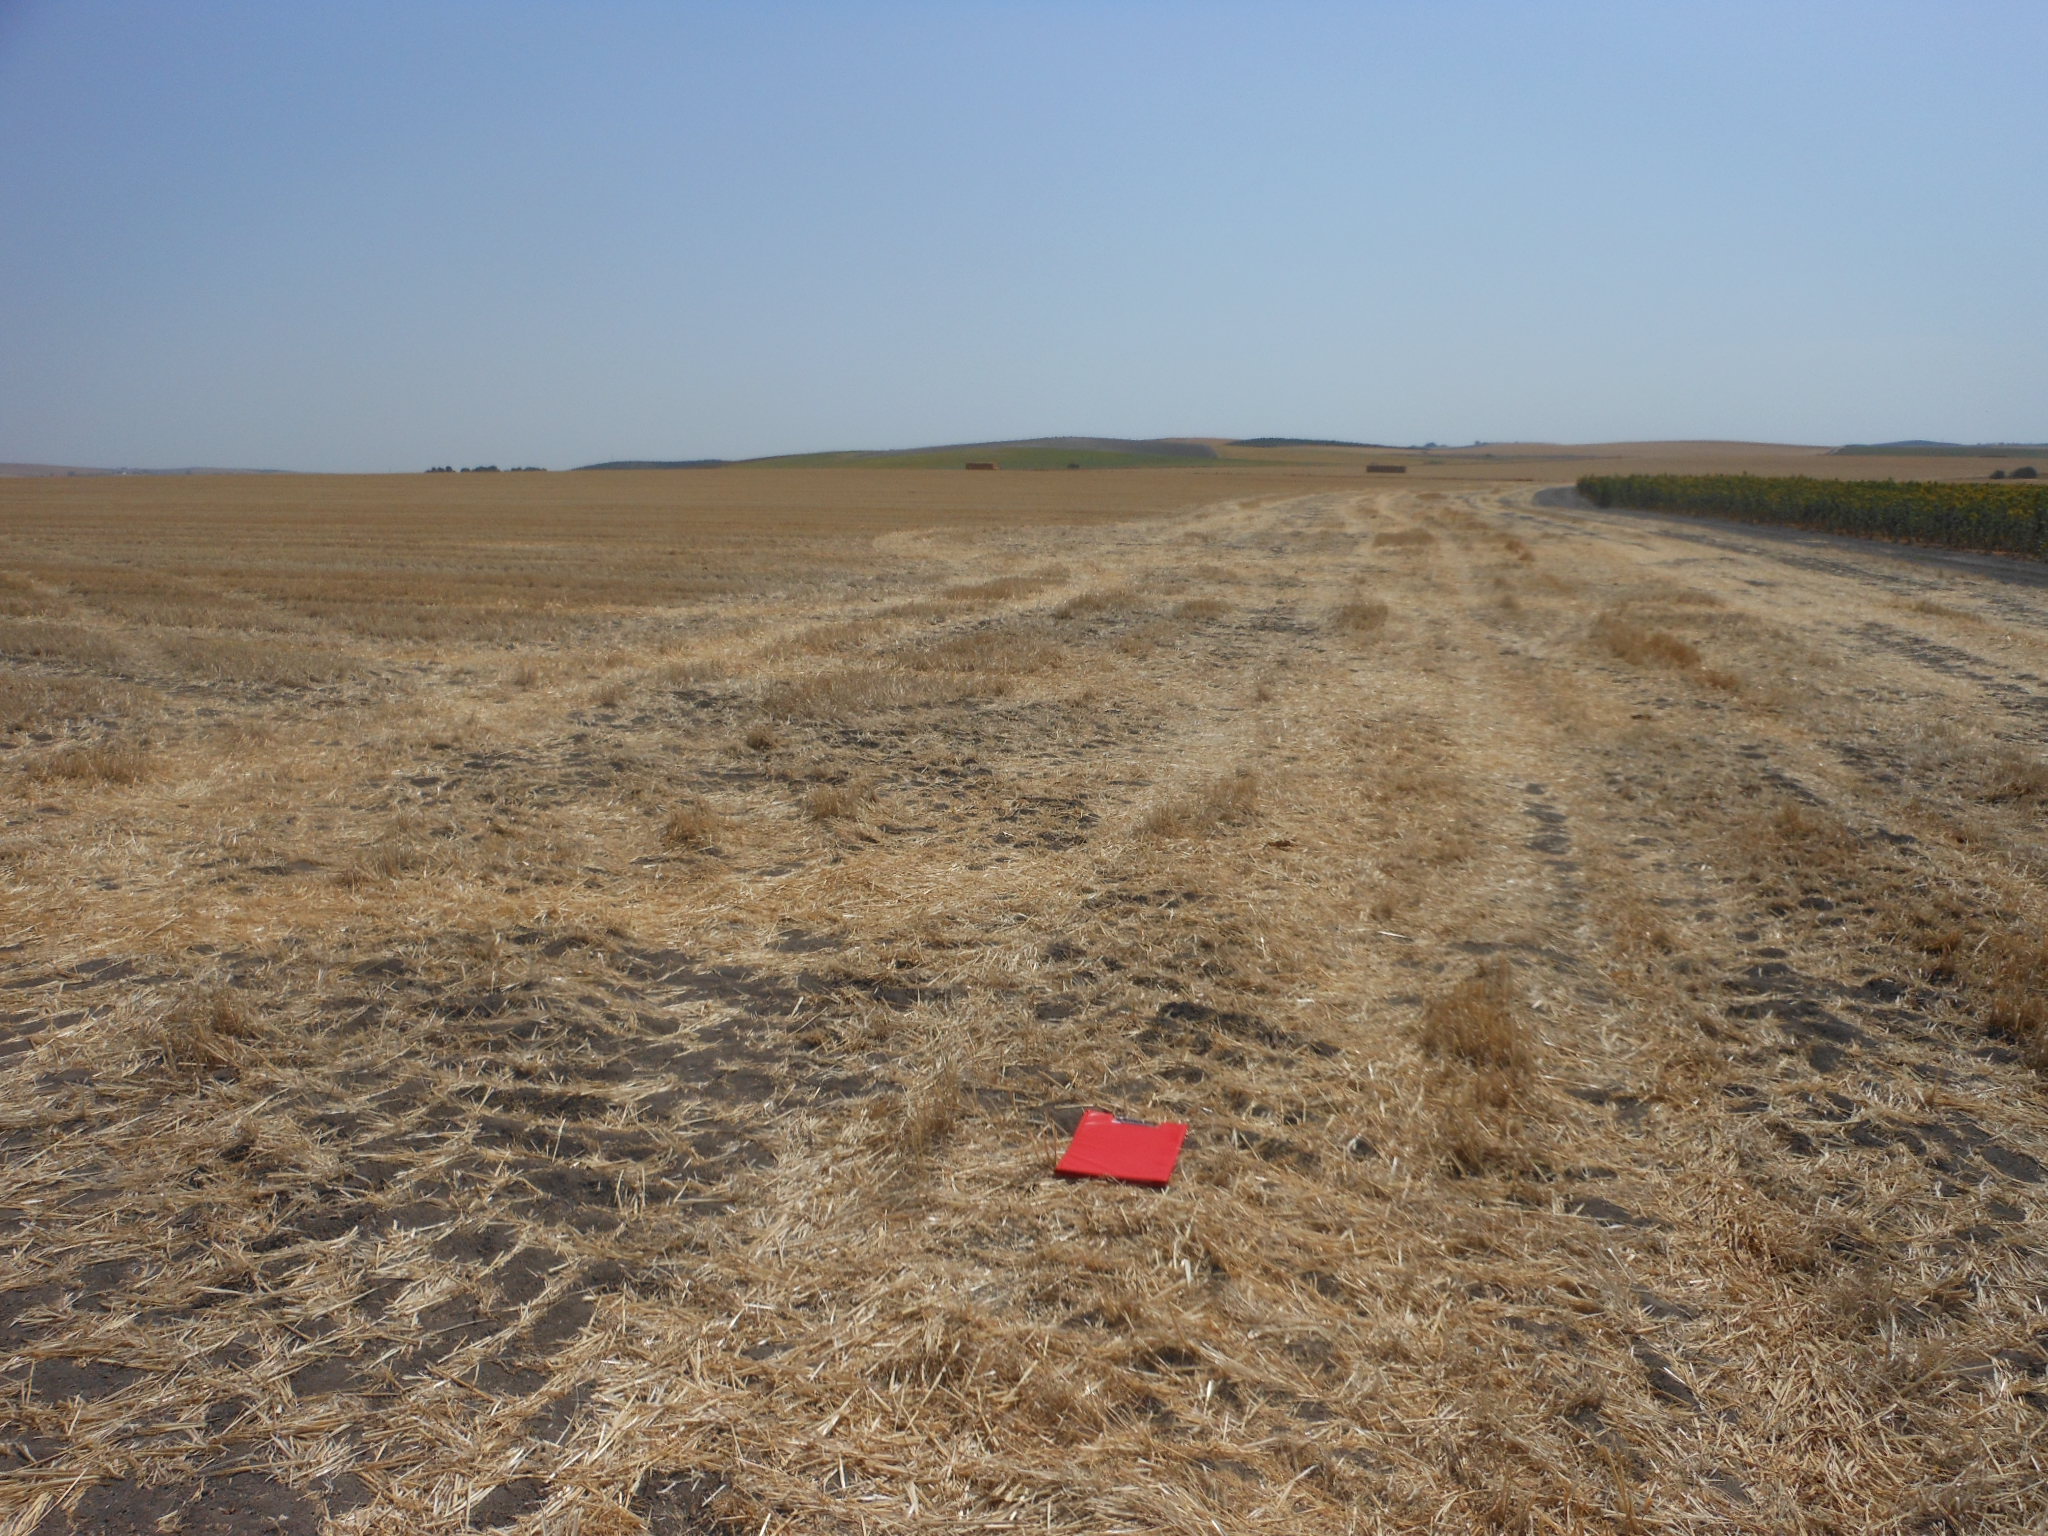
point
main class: Cropland
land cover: Durum wheat
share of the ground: < 10 %
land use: Agriculture (excluding fallow land and kitchen gardens)
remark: Harvested field
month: June
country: ES
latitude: 37.3937
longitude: -5.1355
